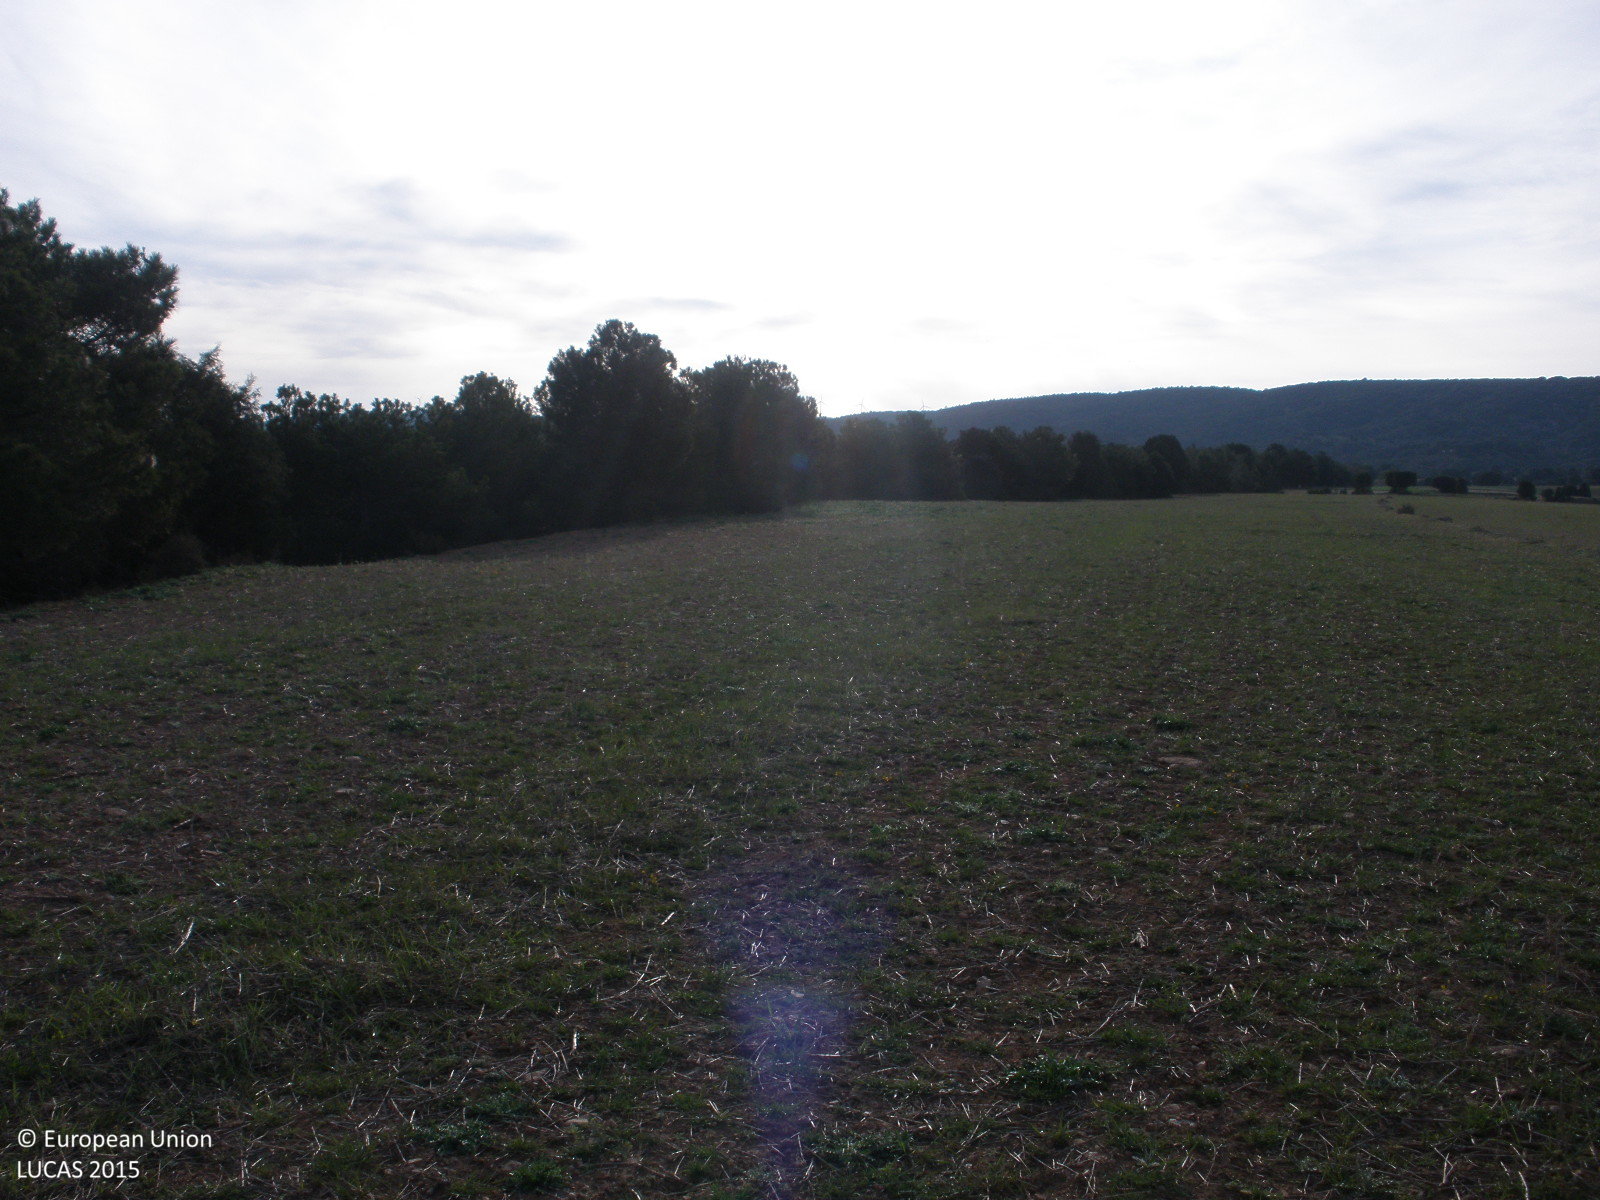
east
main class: Grassland
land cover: Spontaneously vegetated surfaces
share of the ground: > 75 %
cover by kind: herbaceous plants 85 %, unconsolidated bare surface 15 %
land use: Agriculture (excluding fallow land and kitchen gardens)
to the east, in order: Spontaneously vegetated surfaces; Pine dominated coniferous woodland
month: April
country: ES
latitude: 40.3150
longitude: -1.0597
